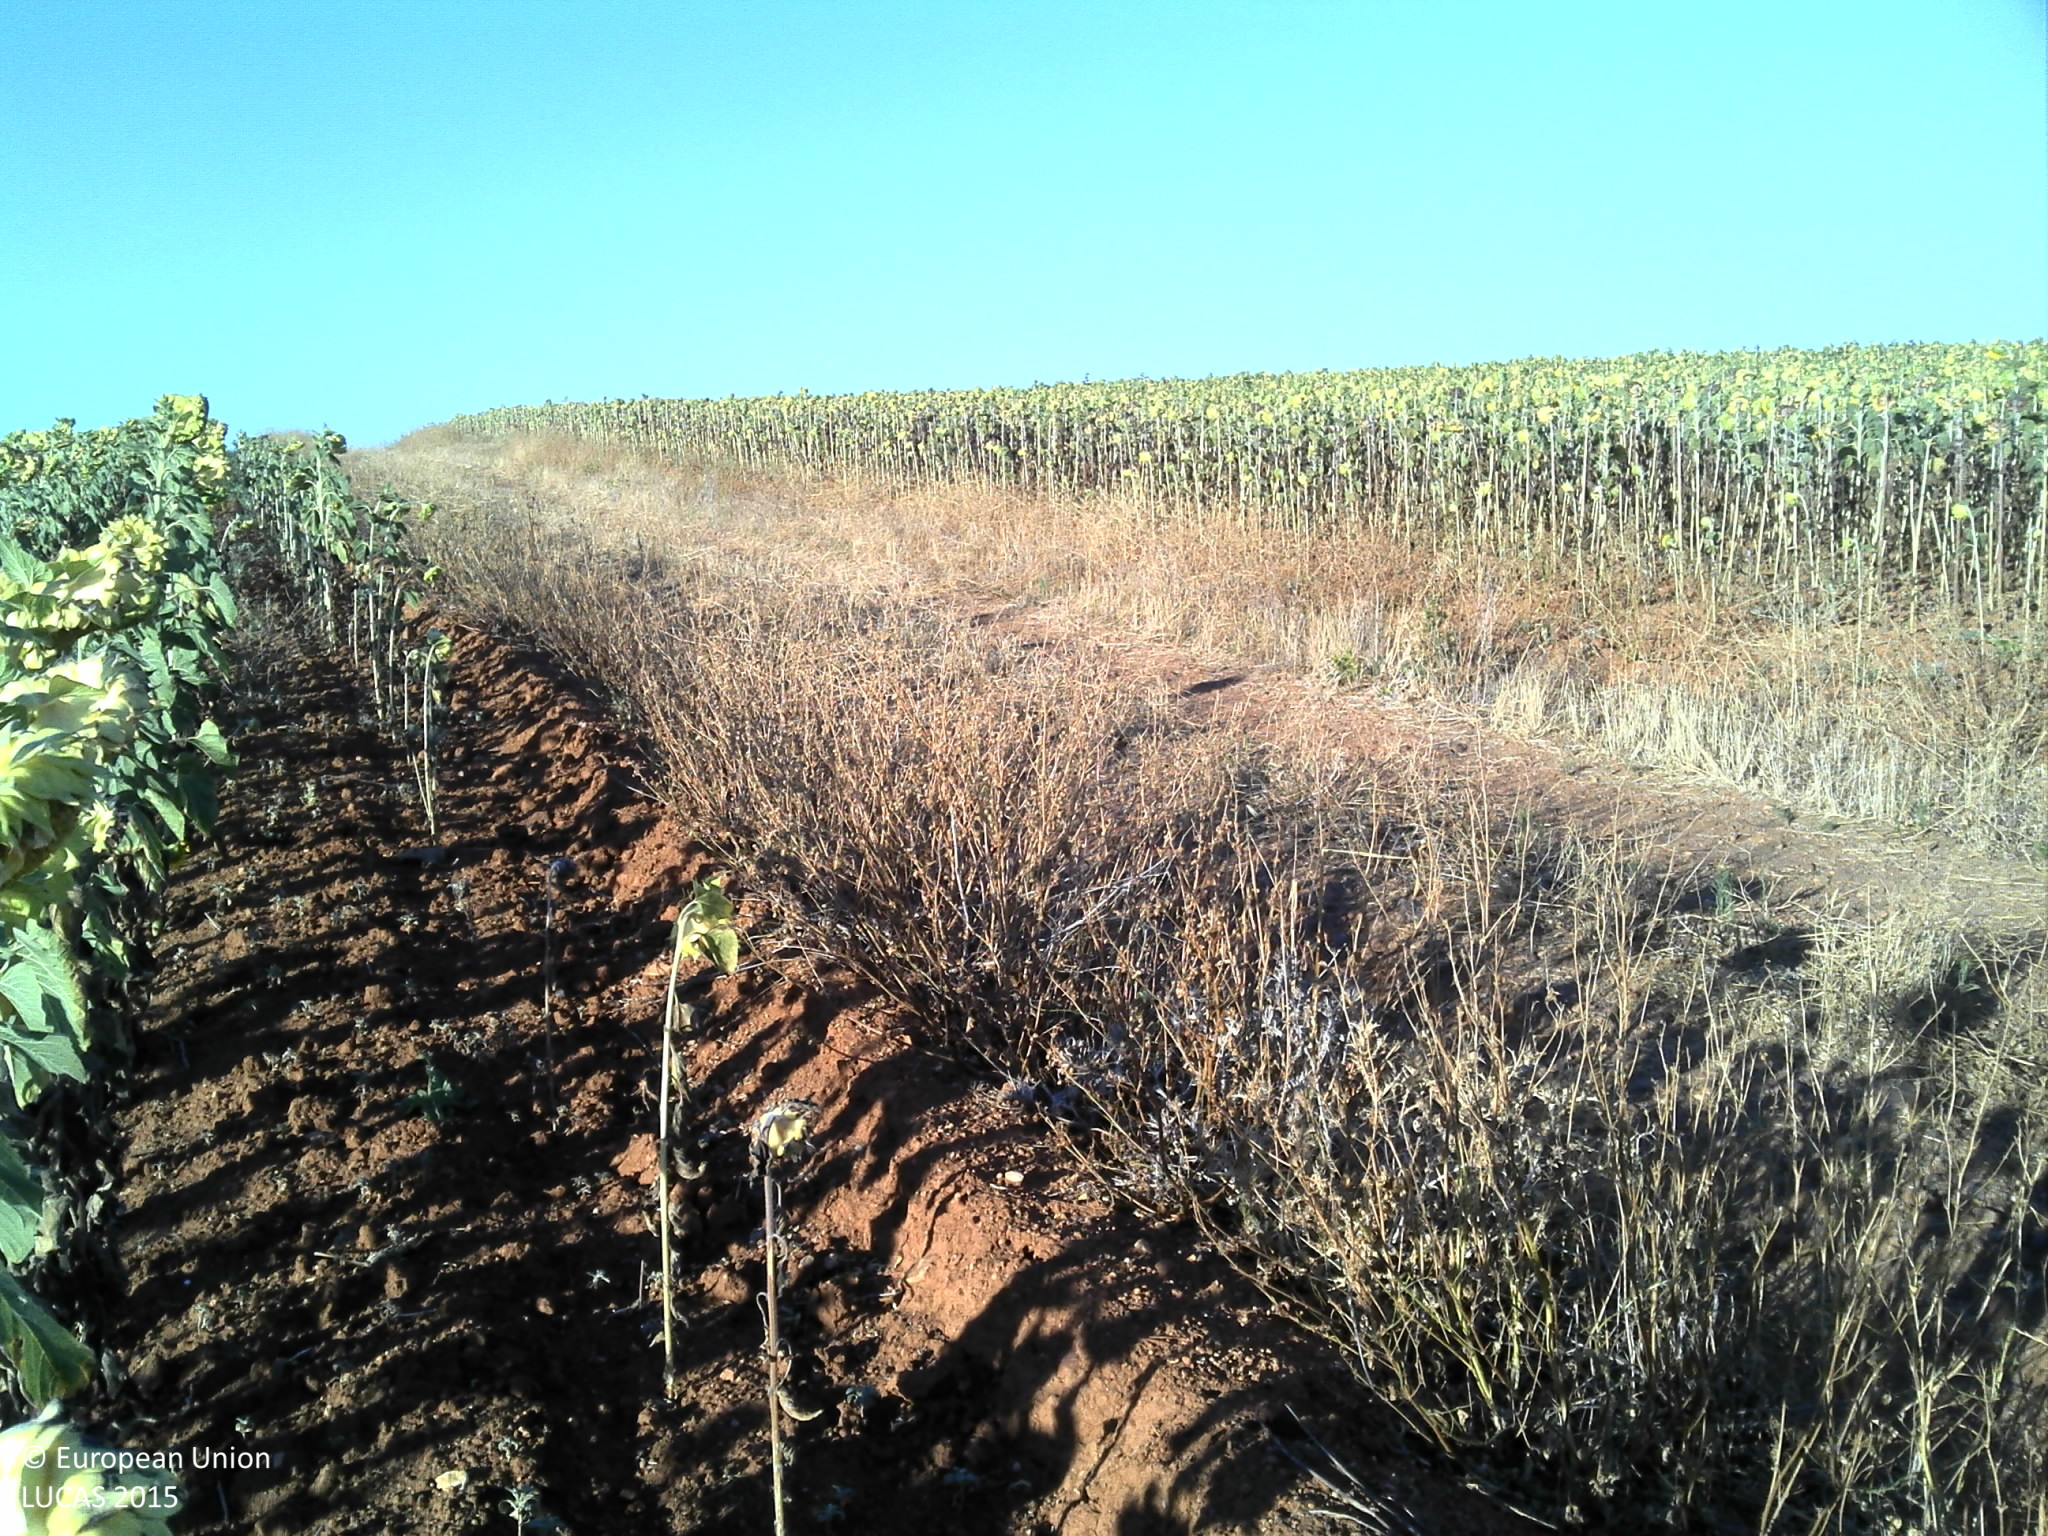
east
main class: Cropland
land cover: Sunflower
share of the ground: > 75 %
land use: Agriculture (excluding fallow land and kitchen gardens)
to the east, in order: Sunflower; Grass margins; Tracks; Grass margins; Sunflower
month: July
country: PT
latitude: 38.0925
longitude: -7.3841
